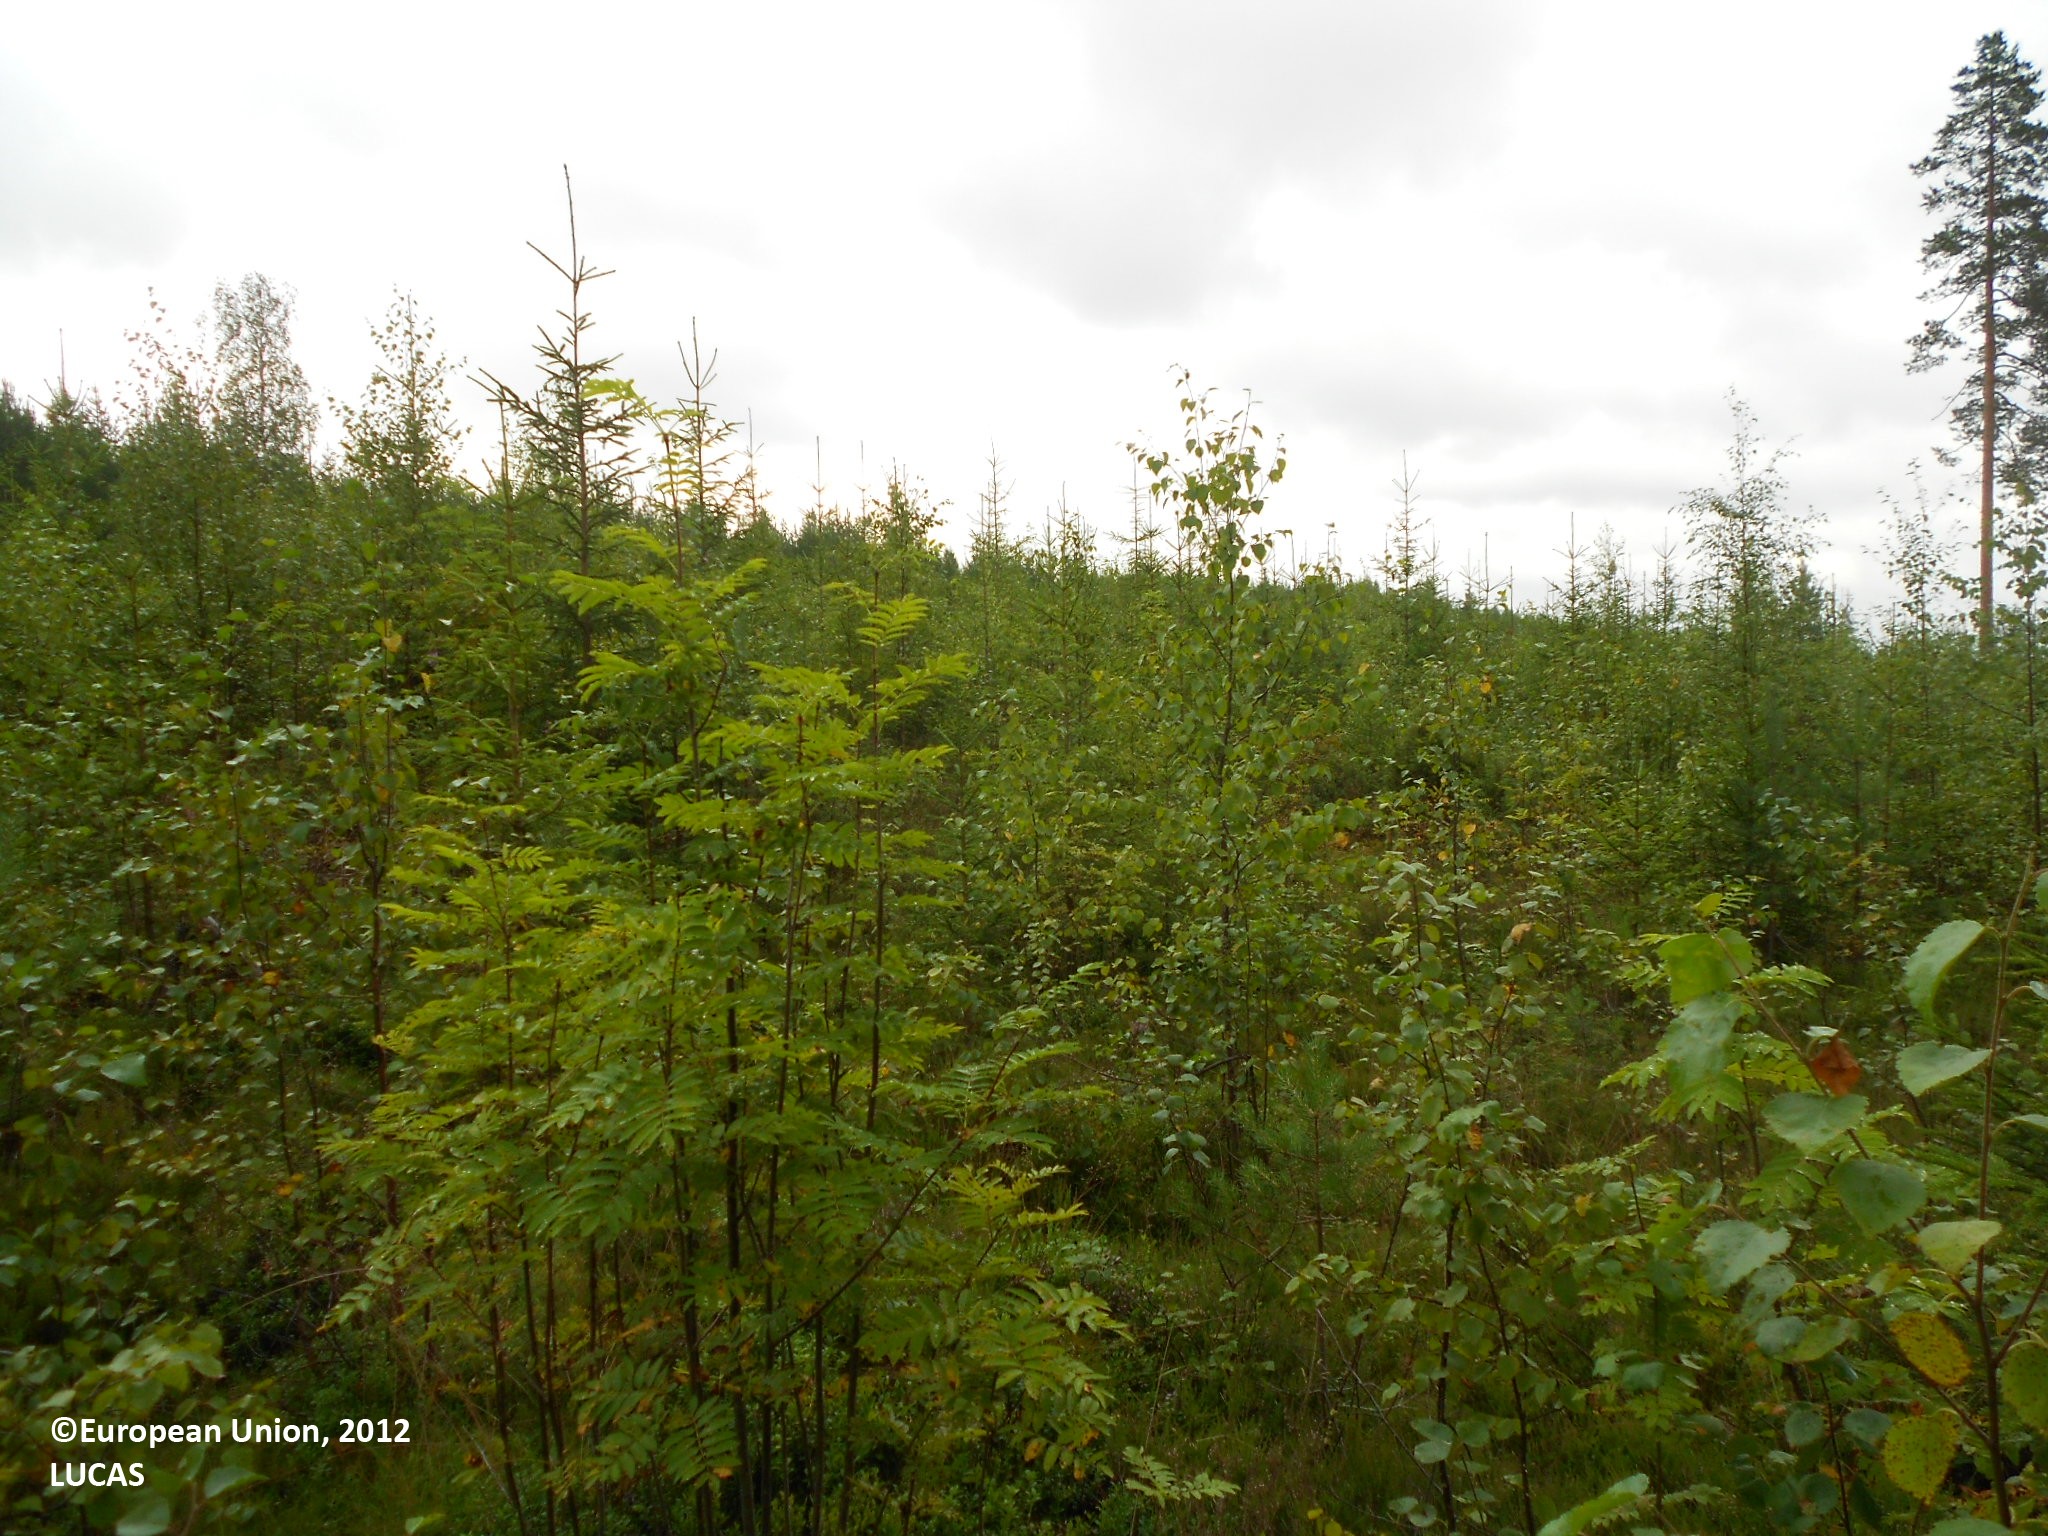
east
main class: Woodland
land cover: Spruce dominated mixed woodland
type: boreal forest
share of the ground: 50 - 75 %
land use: Forestry
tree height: < 5 m
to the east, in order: Spruce dominated mixed woodland; Ditches and canals; Grass margins; Tracks; Grass margins; Ditches and canals; Spruce dominated mixed woodland
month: August
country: FI
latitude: 63.3764
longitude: 28.7409
